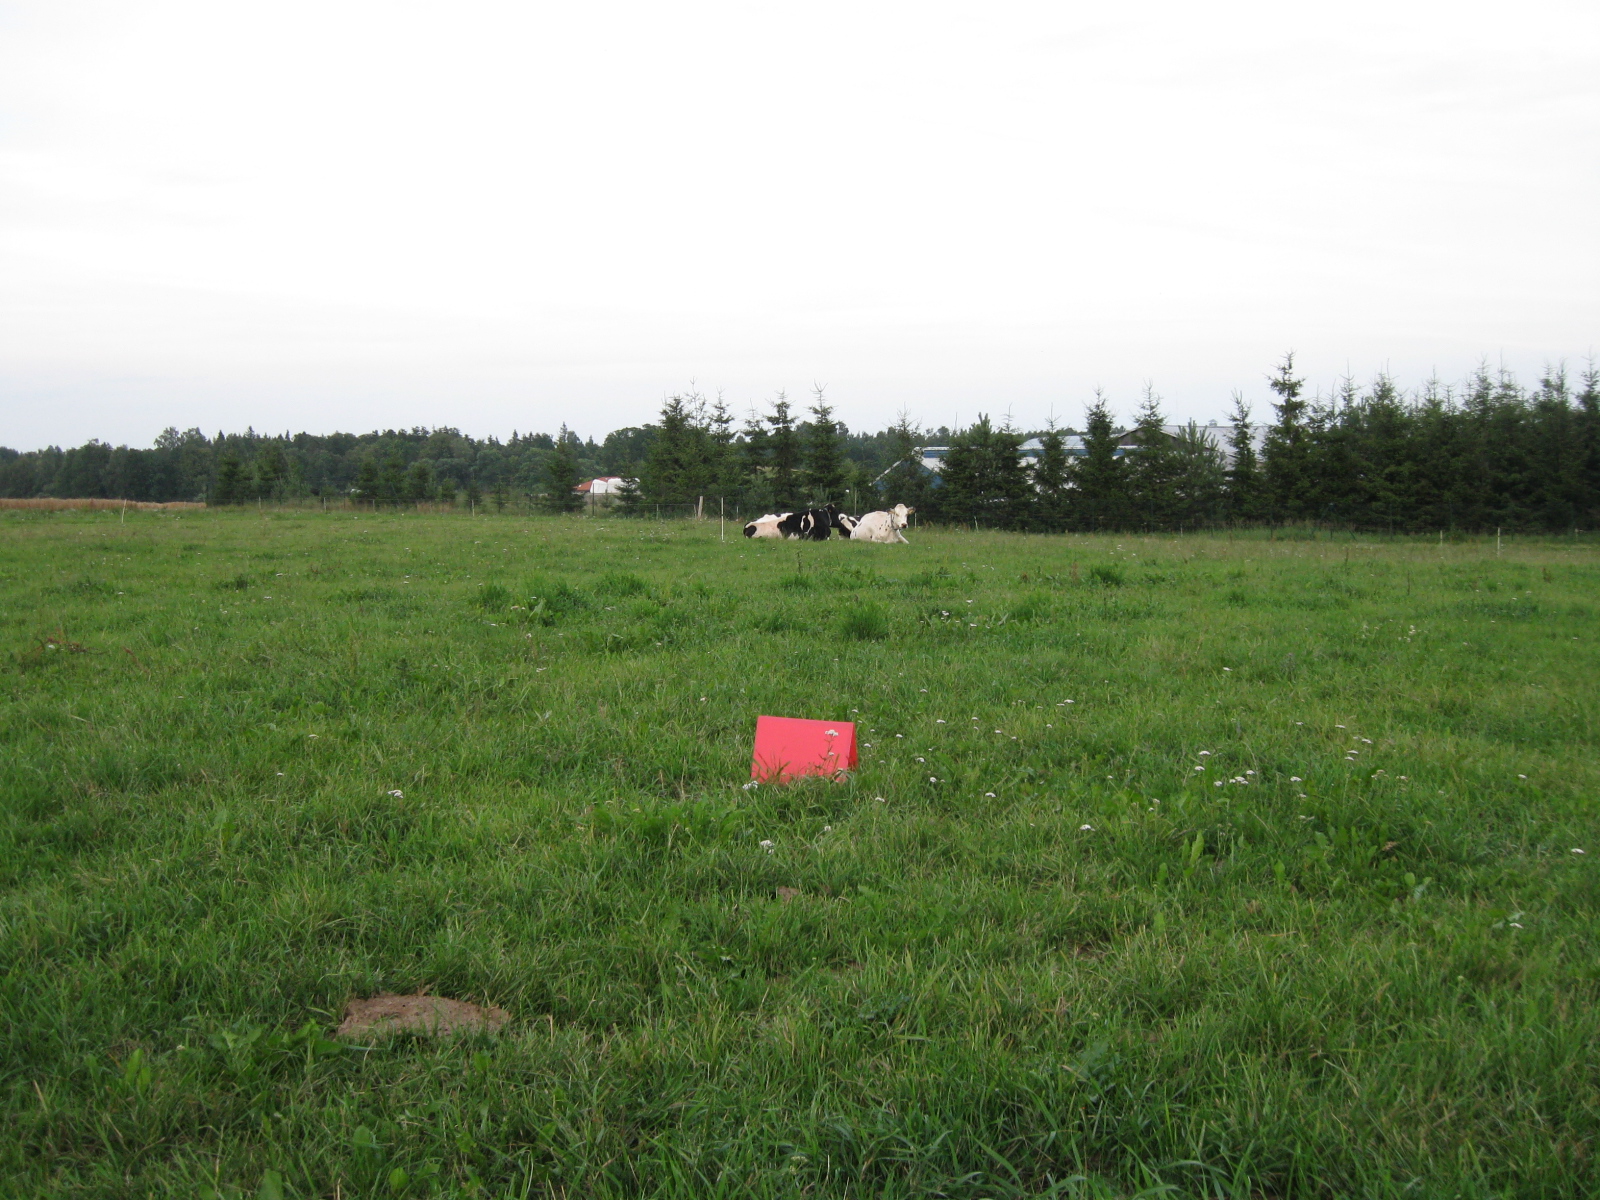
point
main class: Grassland
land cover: Grassland without tree/shrub cover
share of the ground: > 75 %
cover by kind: herbaceous plants 95 %, unconsolidated bare surface 5 %
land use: Agriculture (excluding fallow land and kitchen gardens)
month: July
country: LT
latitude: 54.7075
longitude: 23.7915
